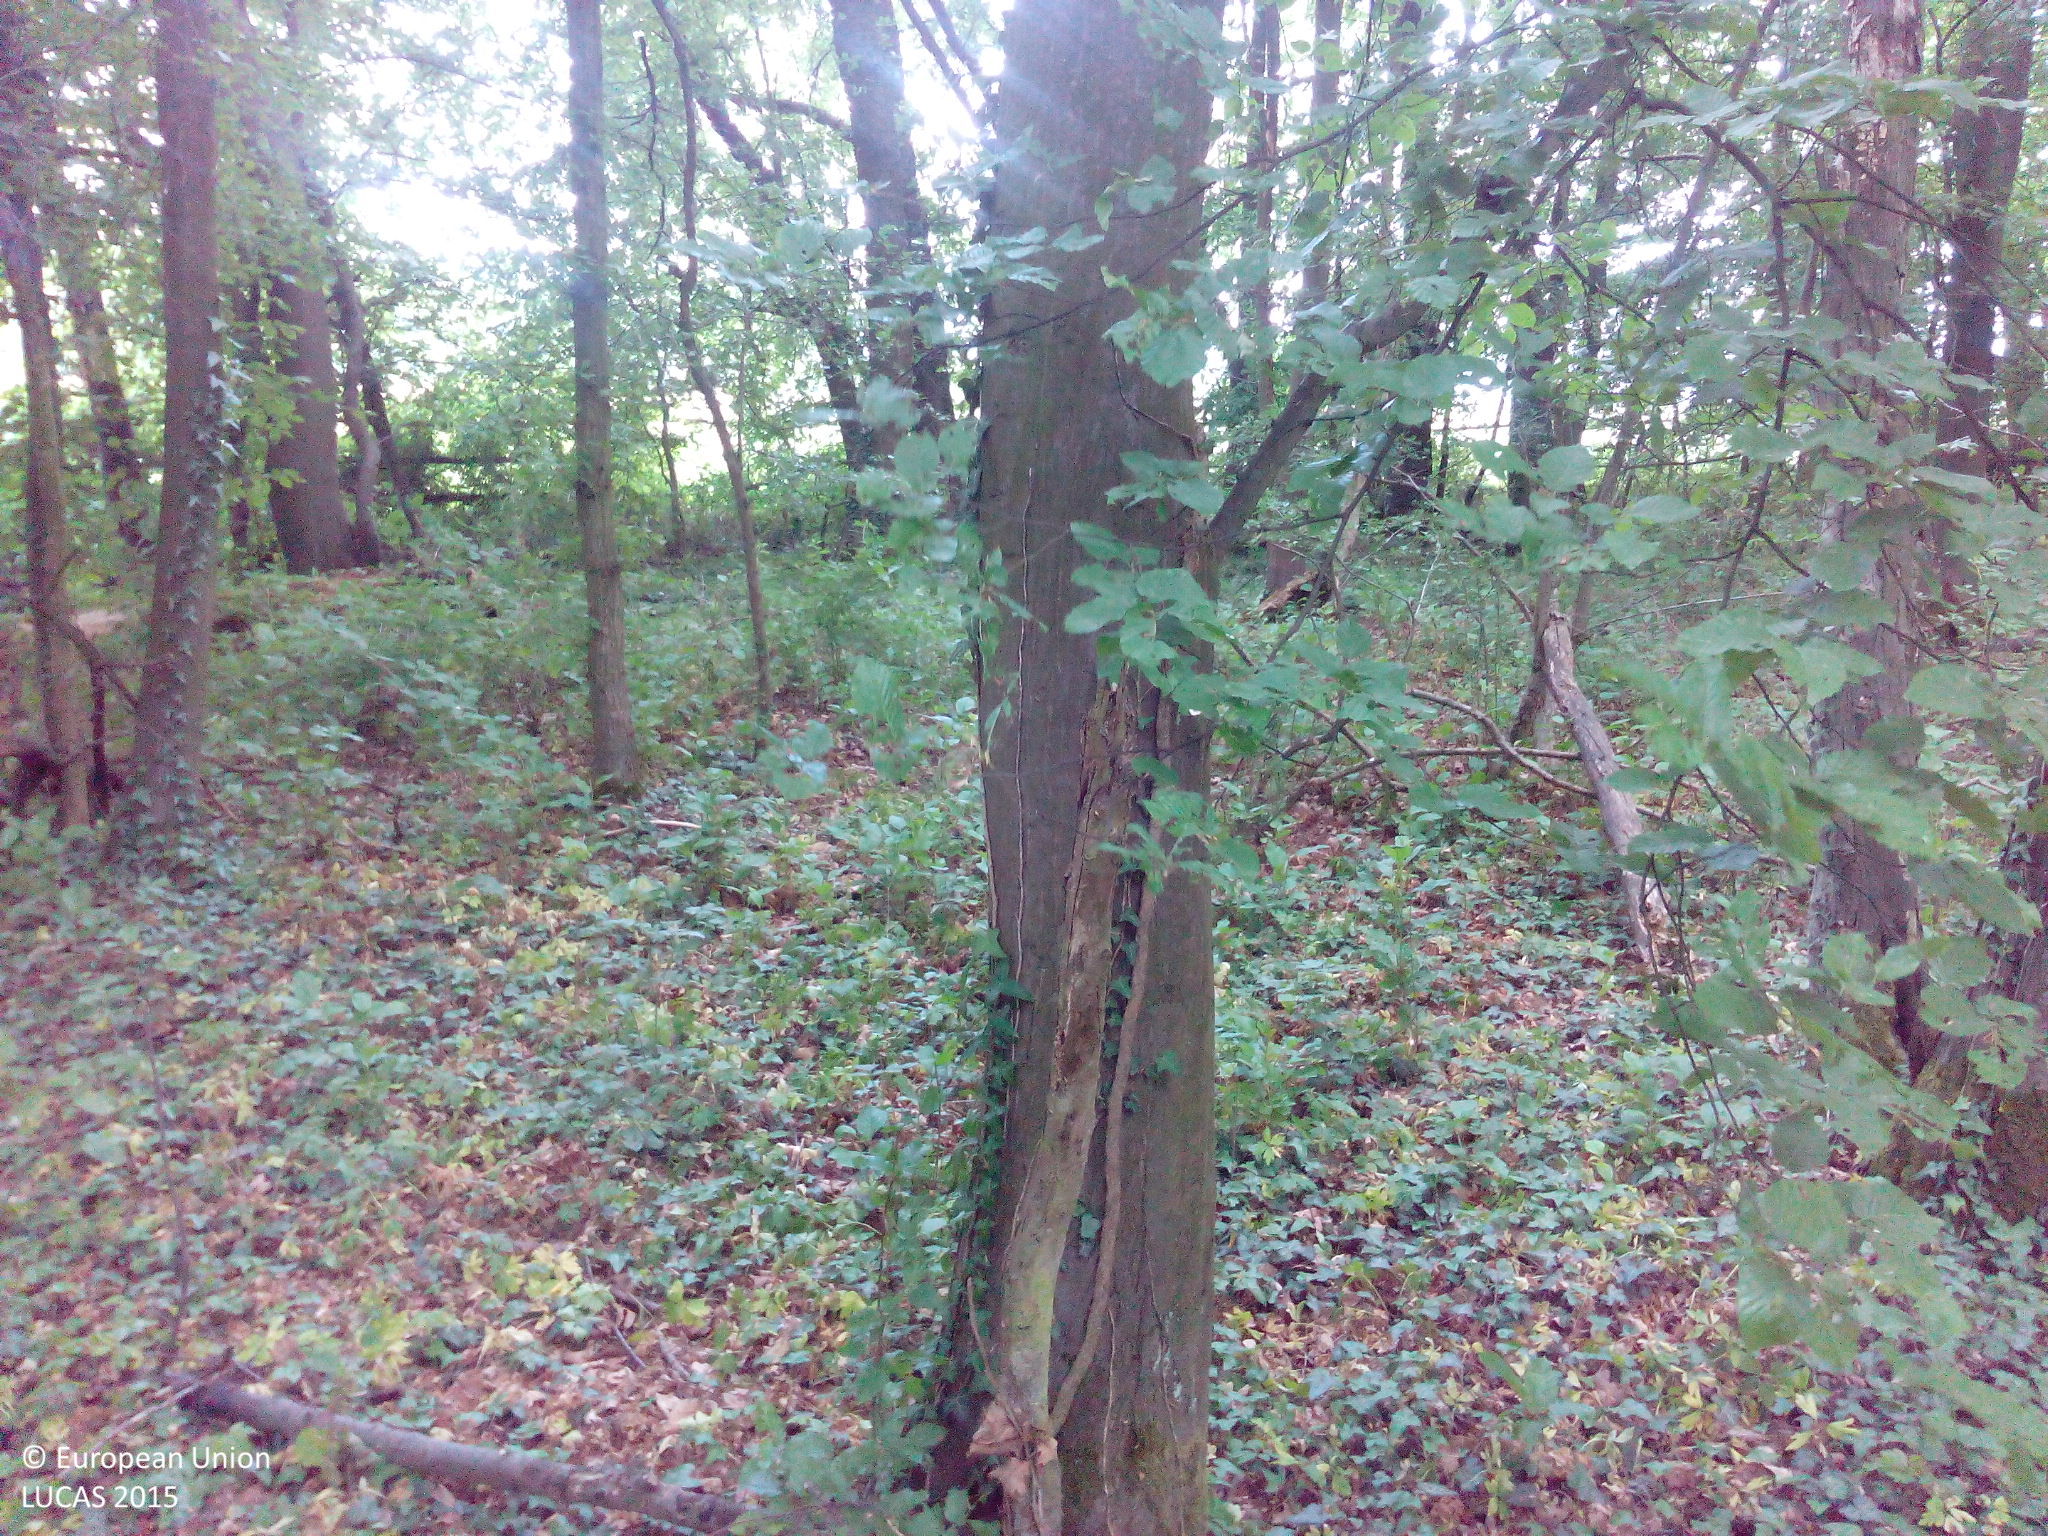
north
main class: Woodland
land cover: Broadleaved woodland
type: mesophytic deciduous forest
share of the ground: > 75 %
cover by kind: broadleaved forest trees 80 %, herbaceous plants 10 %, shrubs 5 %, unconsolidated bare surface 5 %
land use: Forestry
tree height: > 5 m
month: May
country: DE
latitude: 49.9515
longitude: 8.0353
